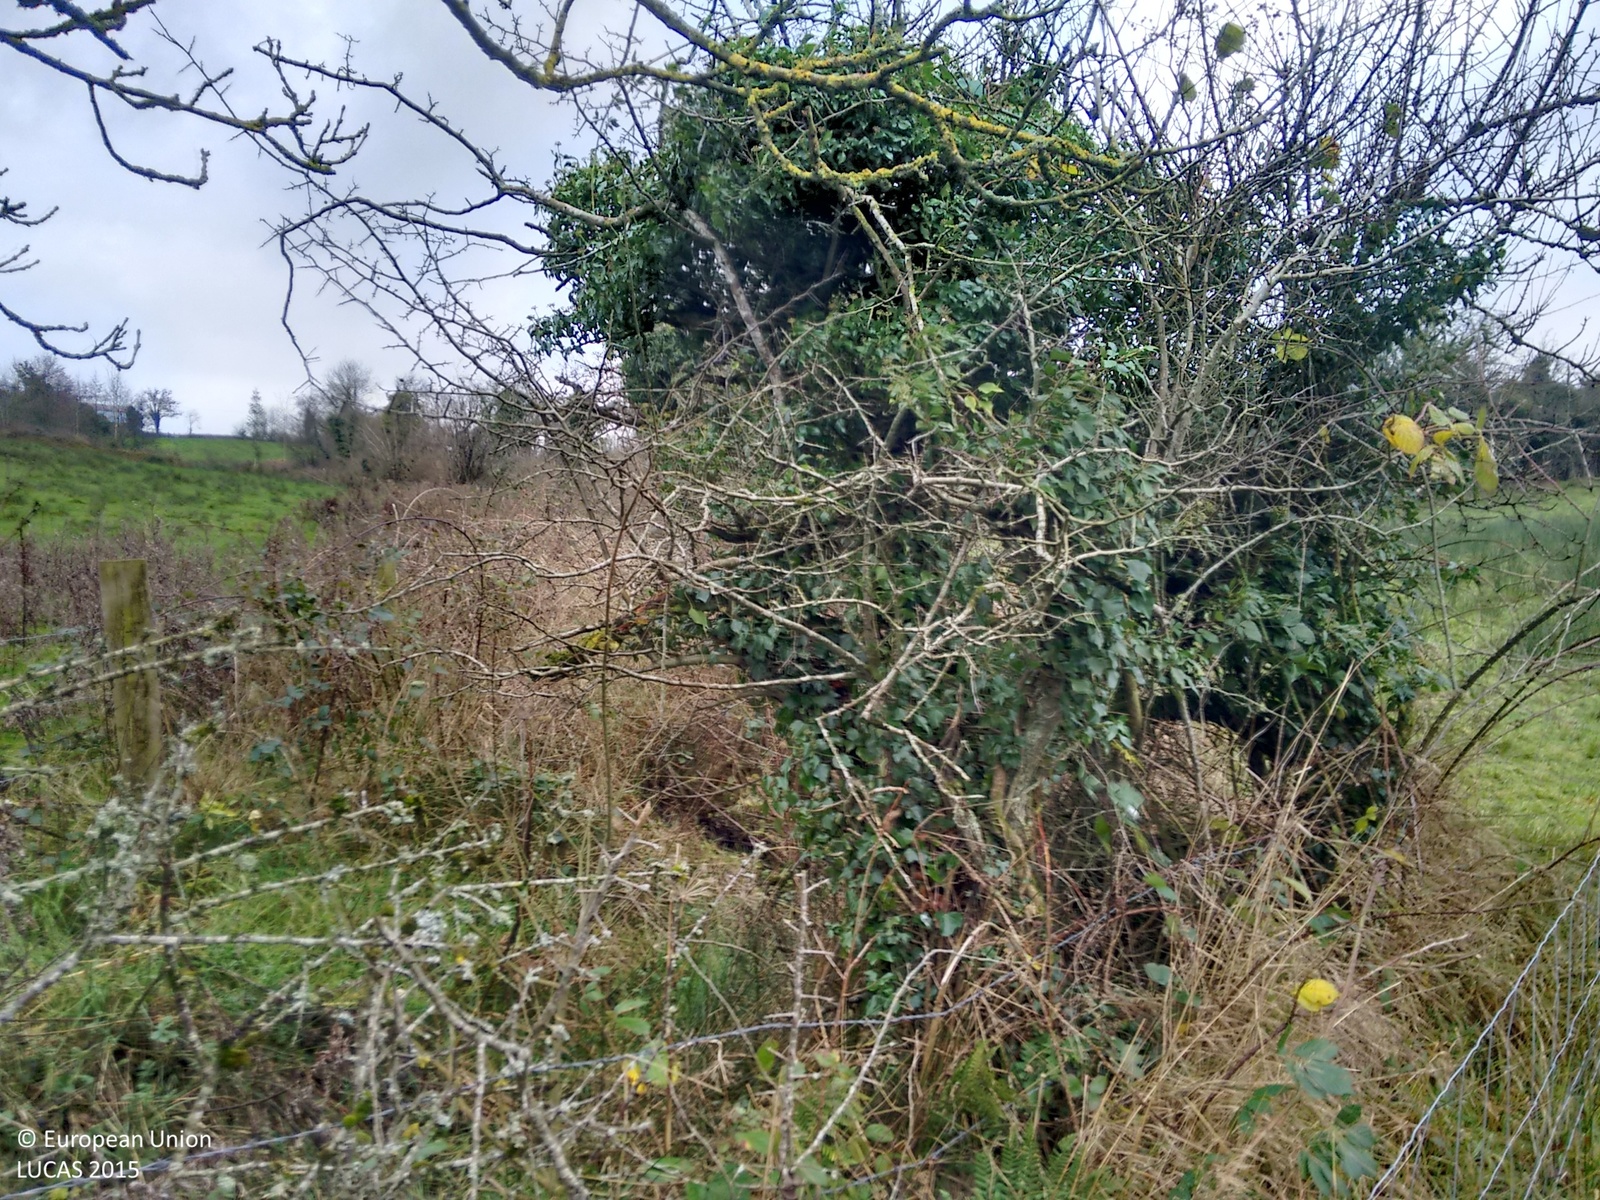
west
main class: Grassland
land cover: Grassland without tree/shrub cover
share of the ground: > 75 %
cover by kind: herbaceous plants 100 %
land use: Agriculture (excluding fallow land and kitchen gardens)
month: December
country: IE
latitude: 54.0529
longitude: -7.2096
